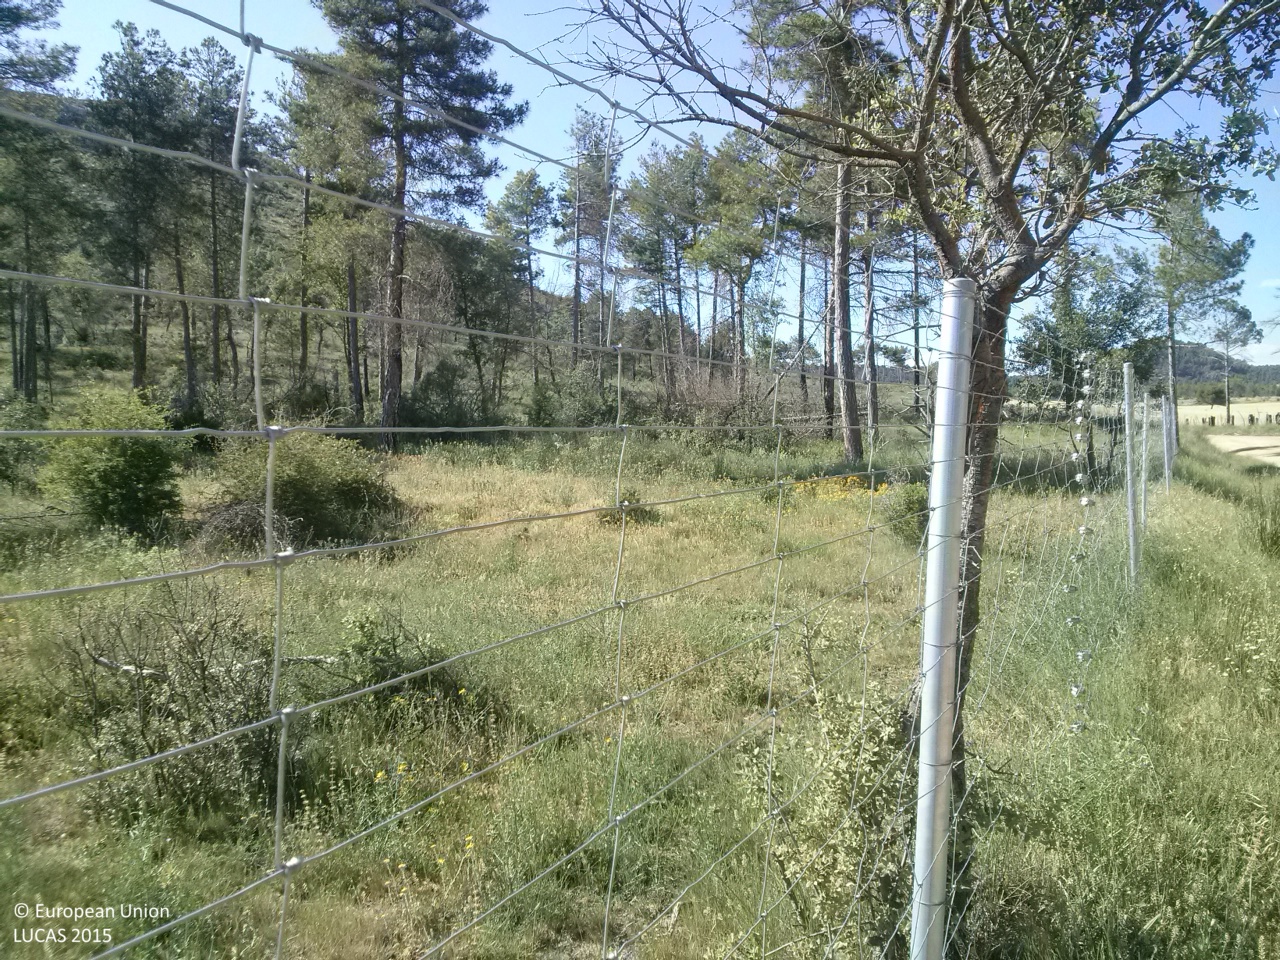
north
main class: Grassland
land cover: Grassland with sparse tree/shrub cover
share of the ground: > 75 %
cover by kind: herbaceous plants 90 %, coniferous forest trees 5 %, shrubs 5 %
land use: Agriculture (excluding fallow land and kitchen gardens)
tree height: > 5 m
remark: Burnt area
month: June
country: ES
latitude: 39.8690
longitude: -1.9011
